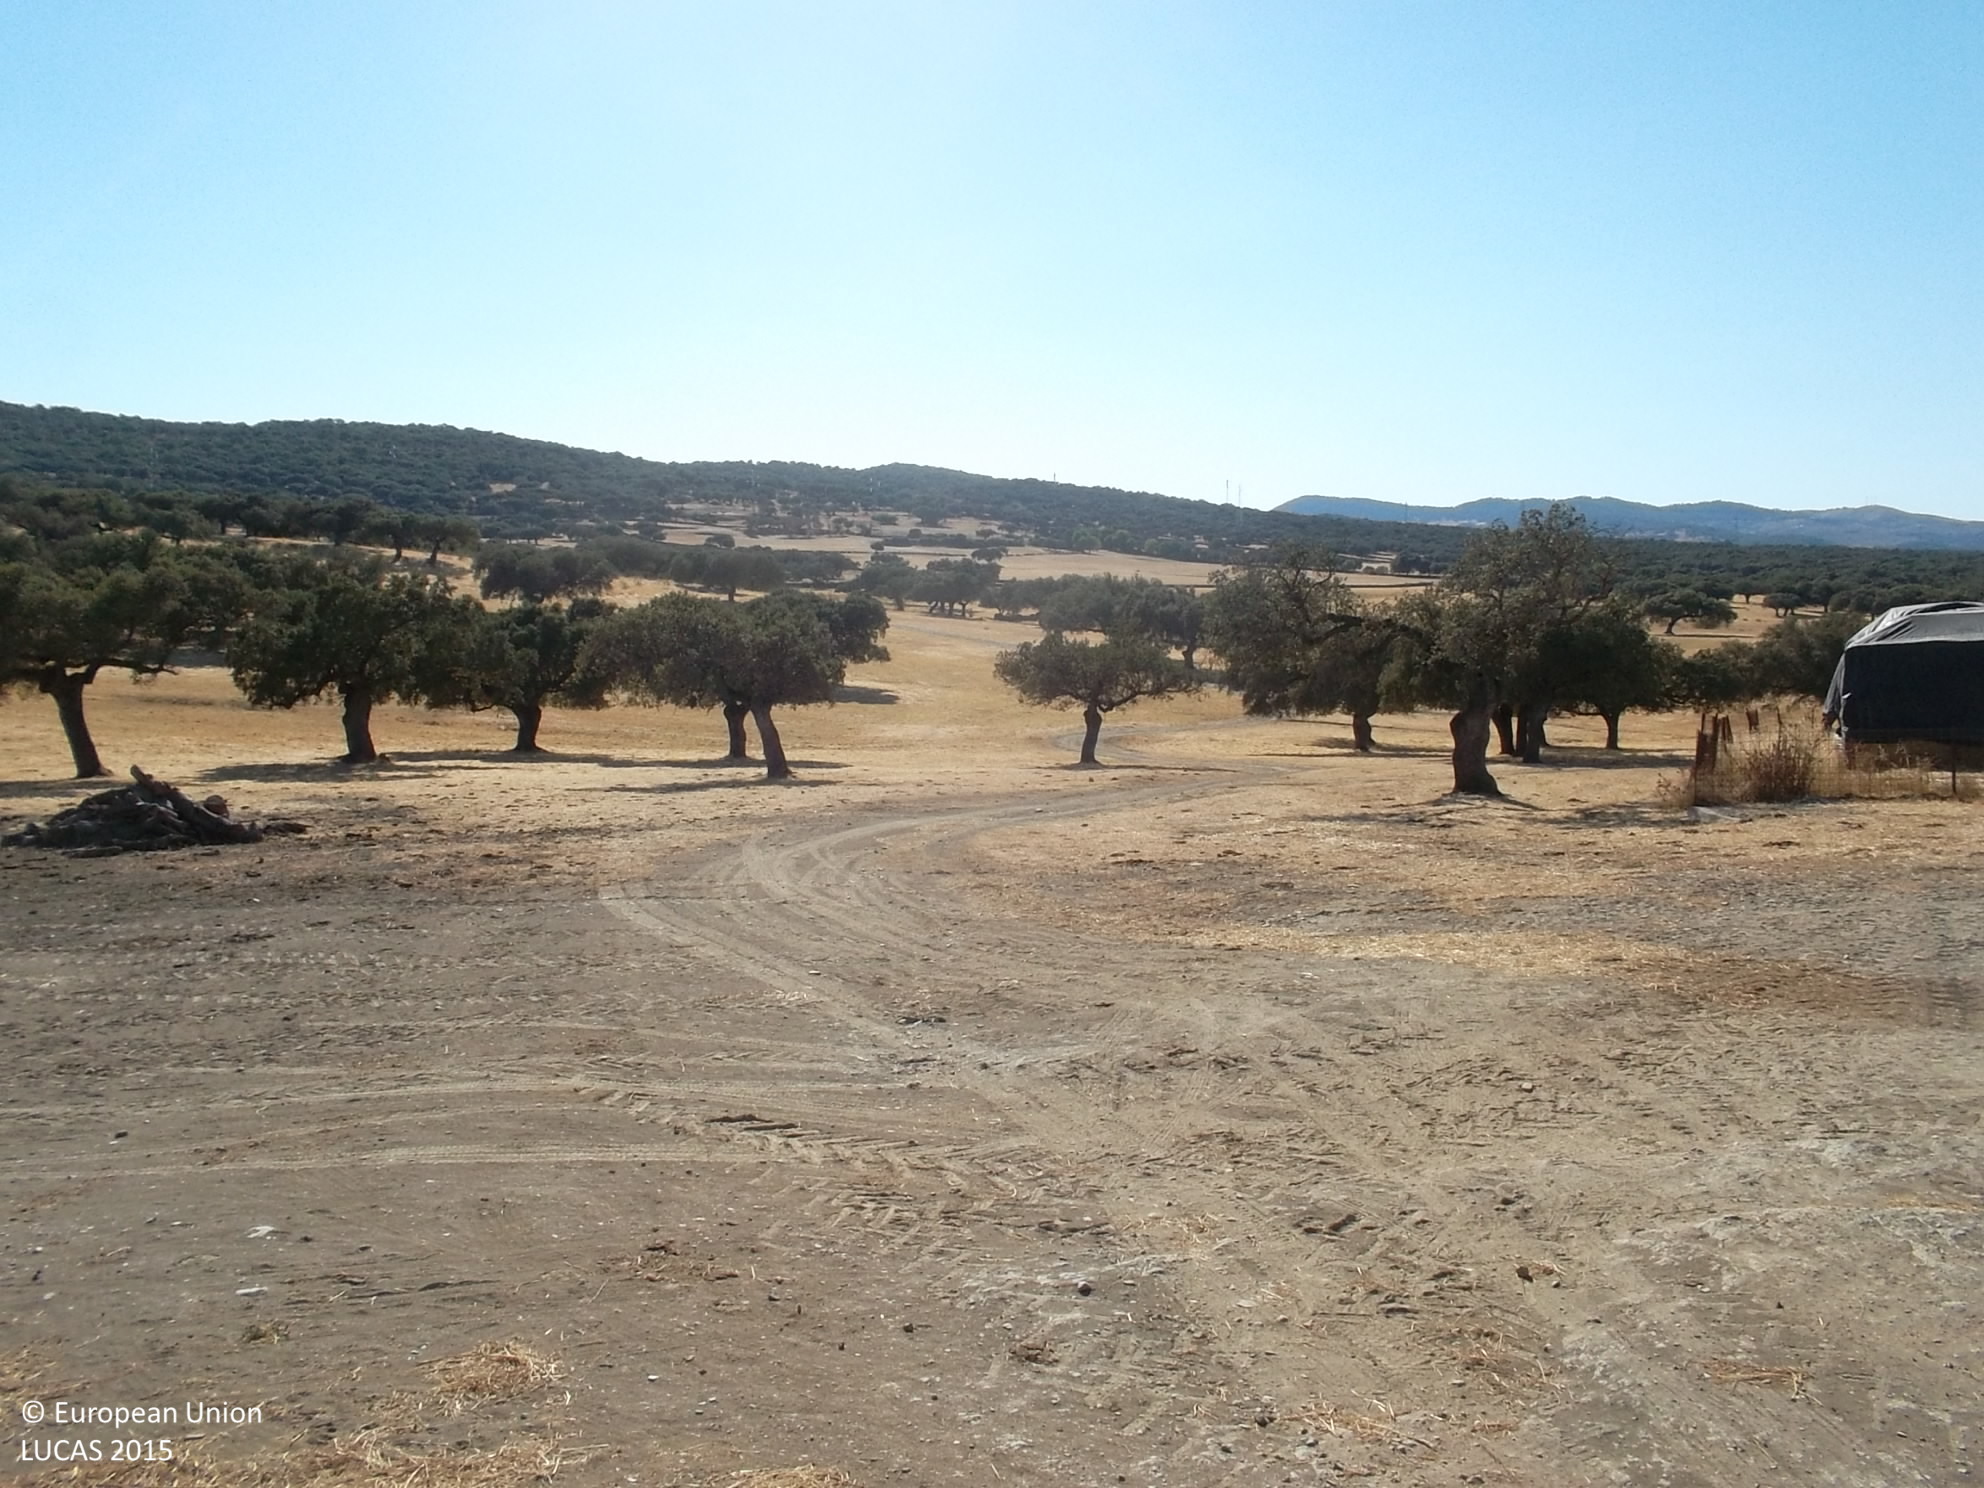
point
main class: Grassland
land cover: Spontaneously vegetated surfaces
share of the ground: > 75 %
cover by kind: herbaceous plants 100 %
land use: Fallow land
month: August
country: ES
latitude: 38.3584
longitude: -6.7291
